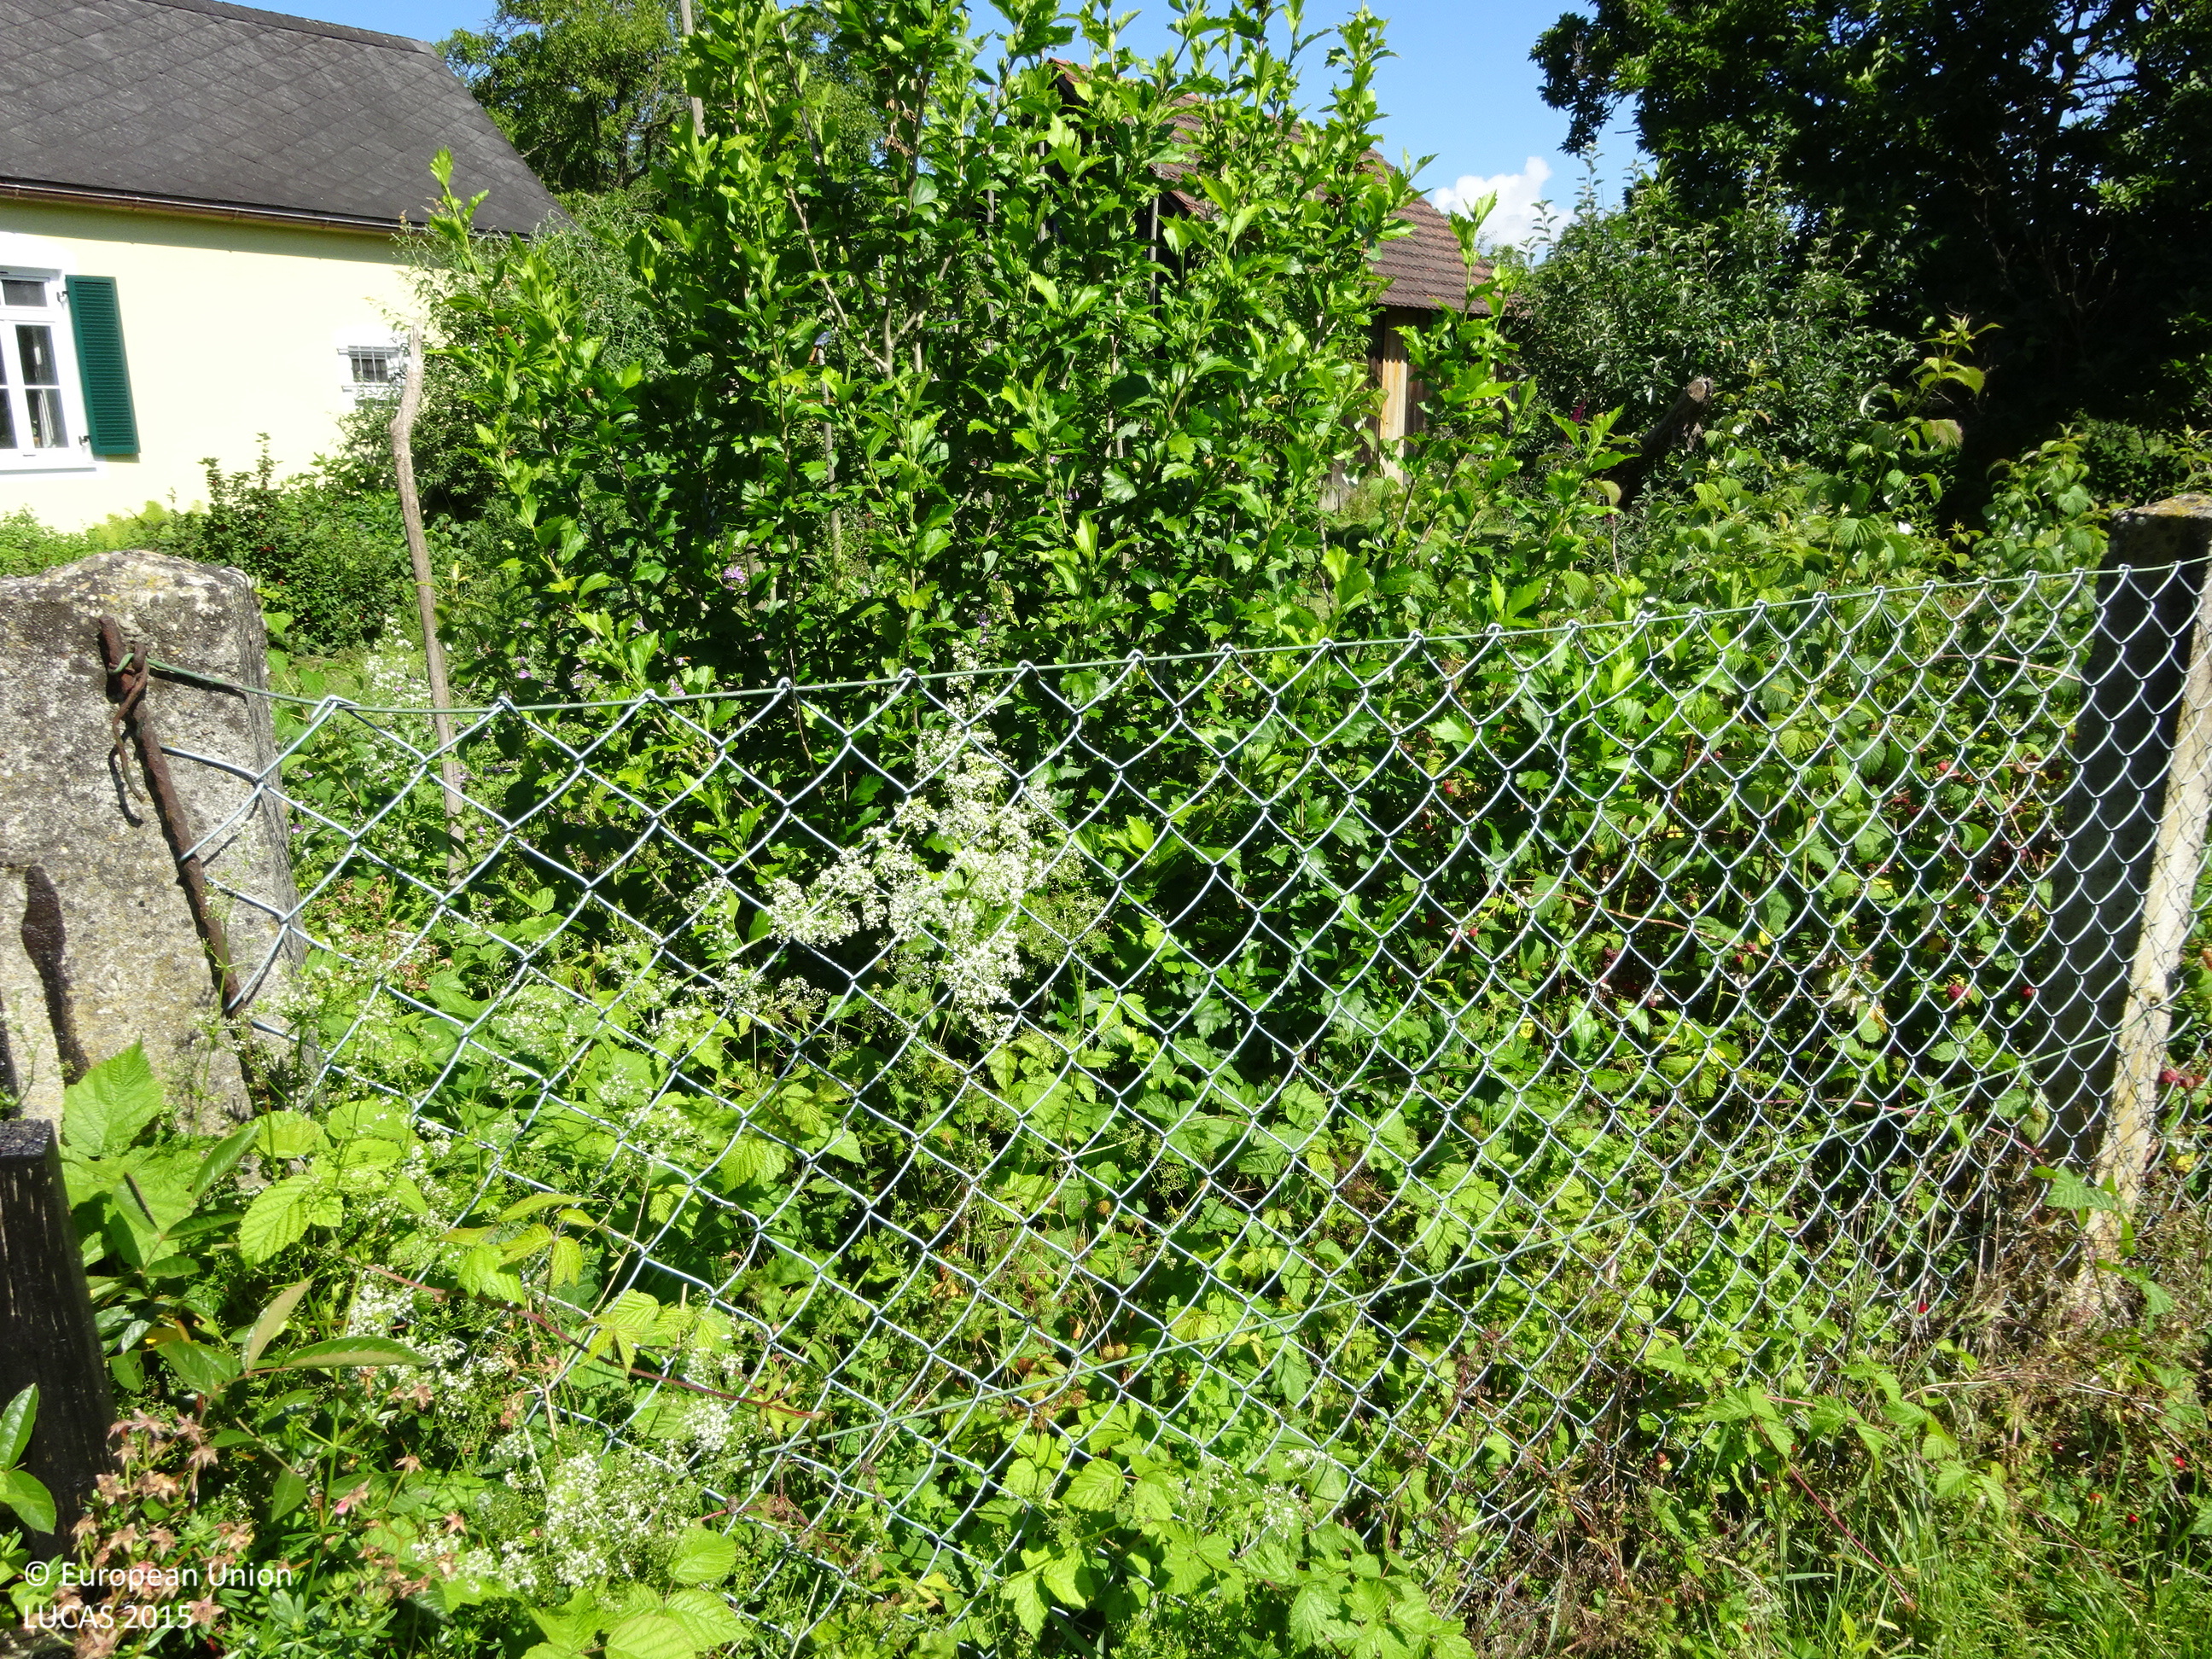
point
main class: Shrubland
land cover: Shrubland without tree cover
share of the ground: 25 - 50 %
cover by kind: herbaceous plants 80 %, shrubs 20 %
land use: Residential
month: June
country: AT
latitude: 46.6883
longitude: 16.0019
